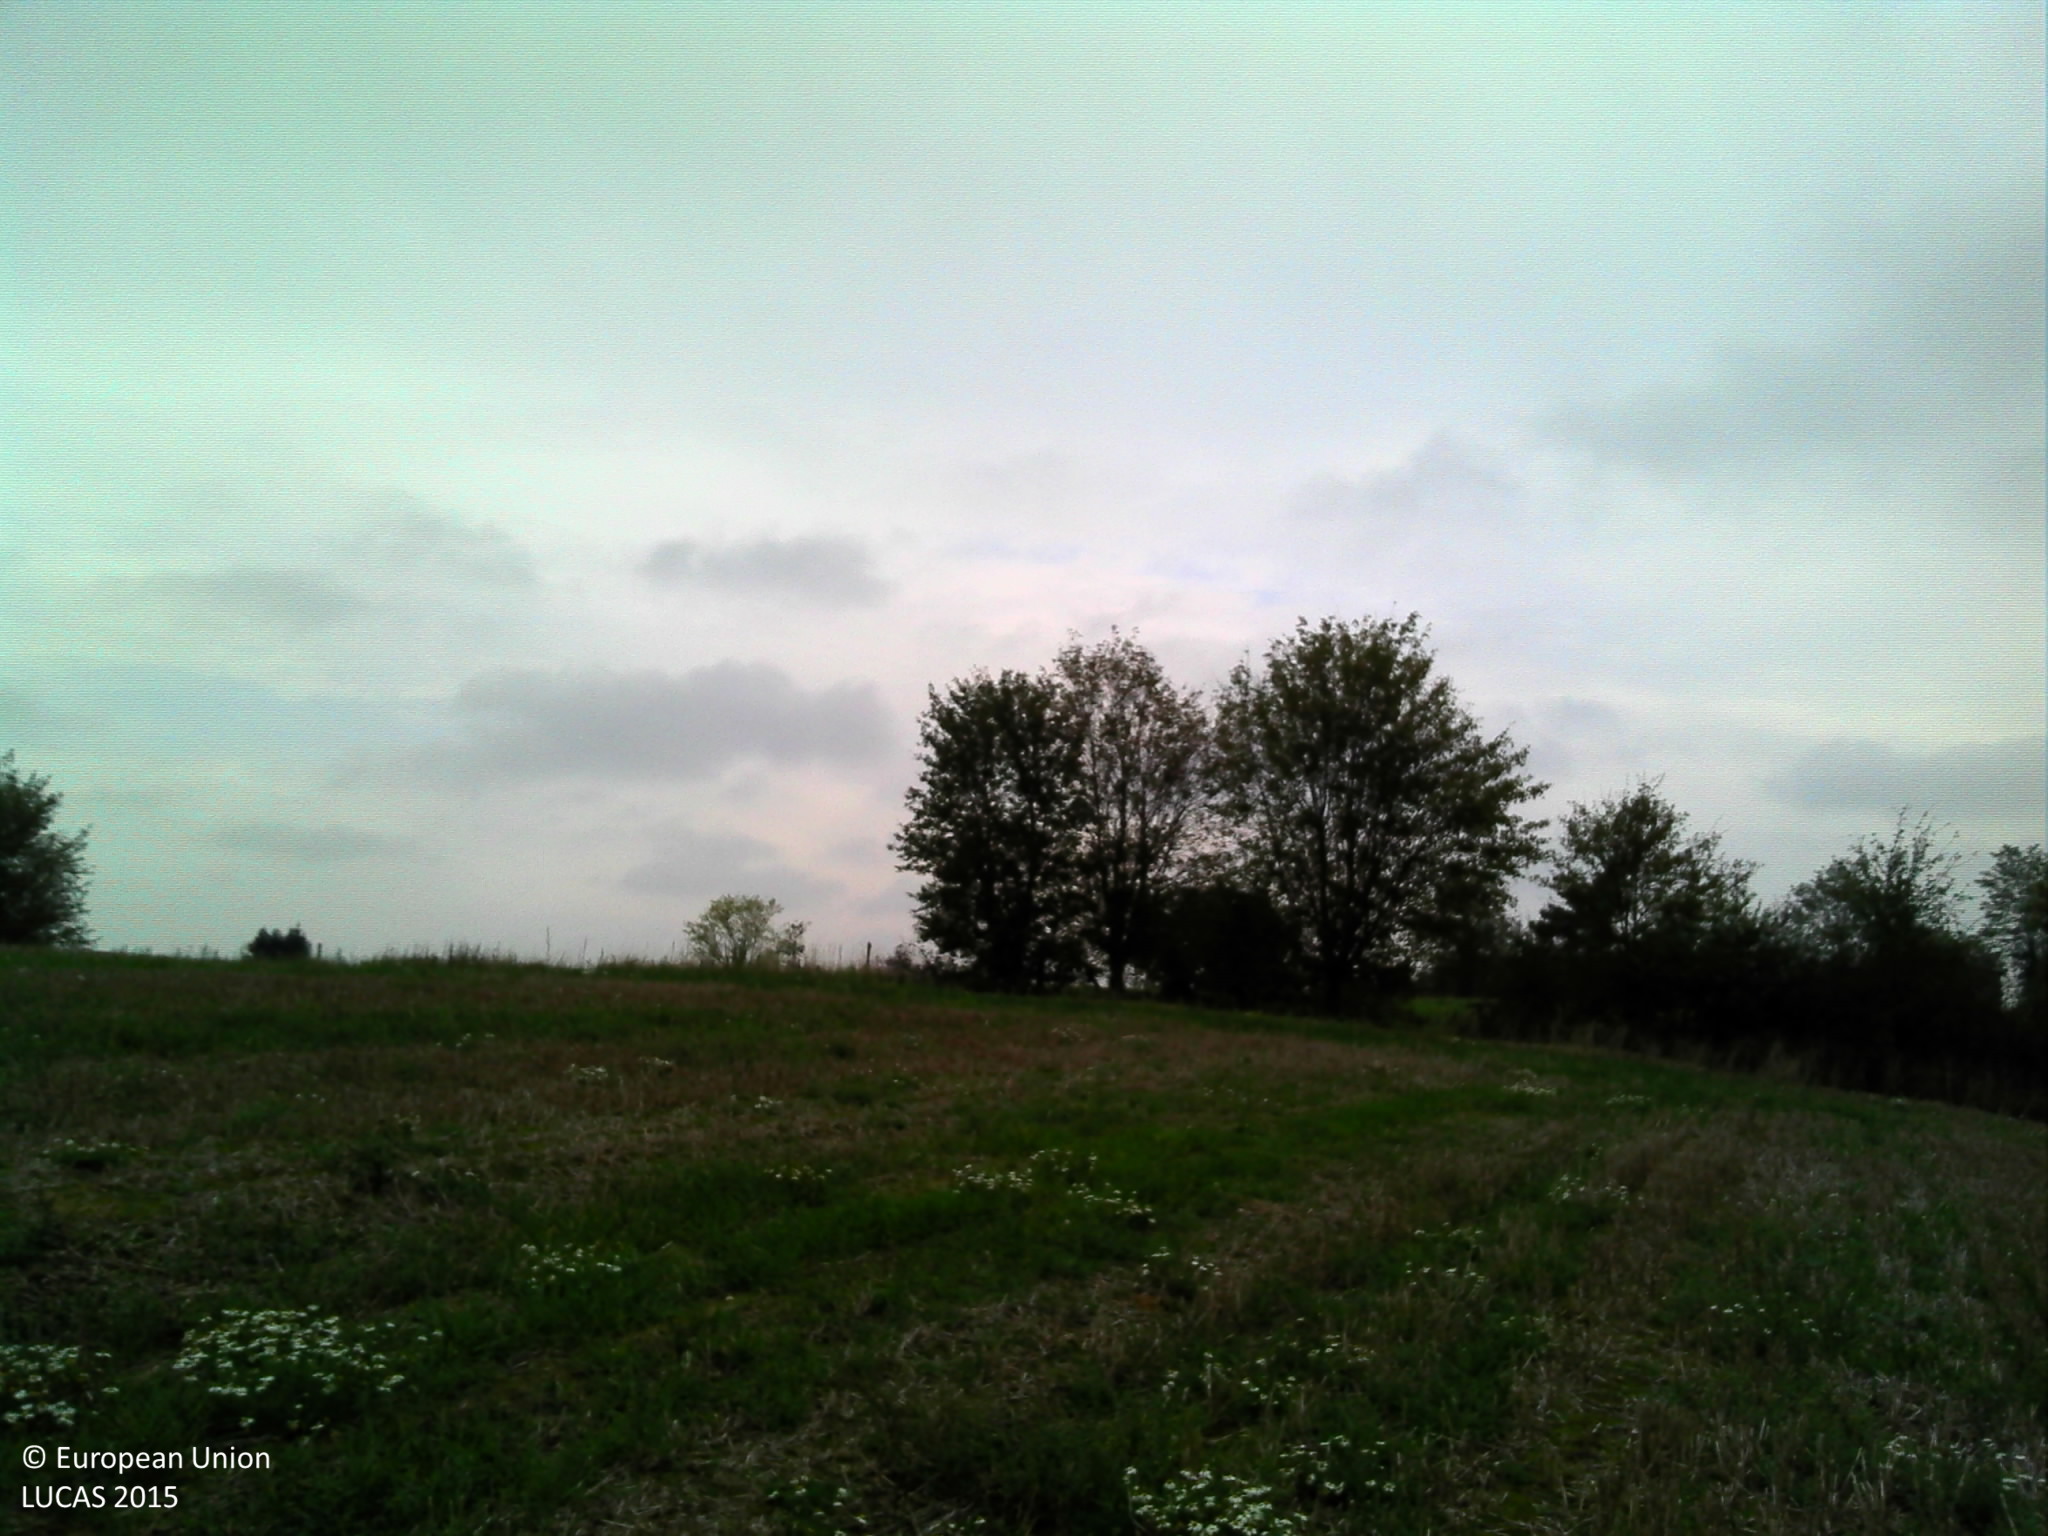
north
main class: Cropland
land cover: Common wheat
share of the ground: > 75 %
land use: Agriculture (excluding fallow land and kitchen gardens)
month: October
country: FR
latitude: 46.1568
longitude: 4.8878
